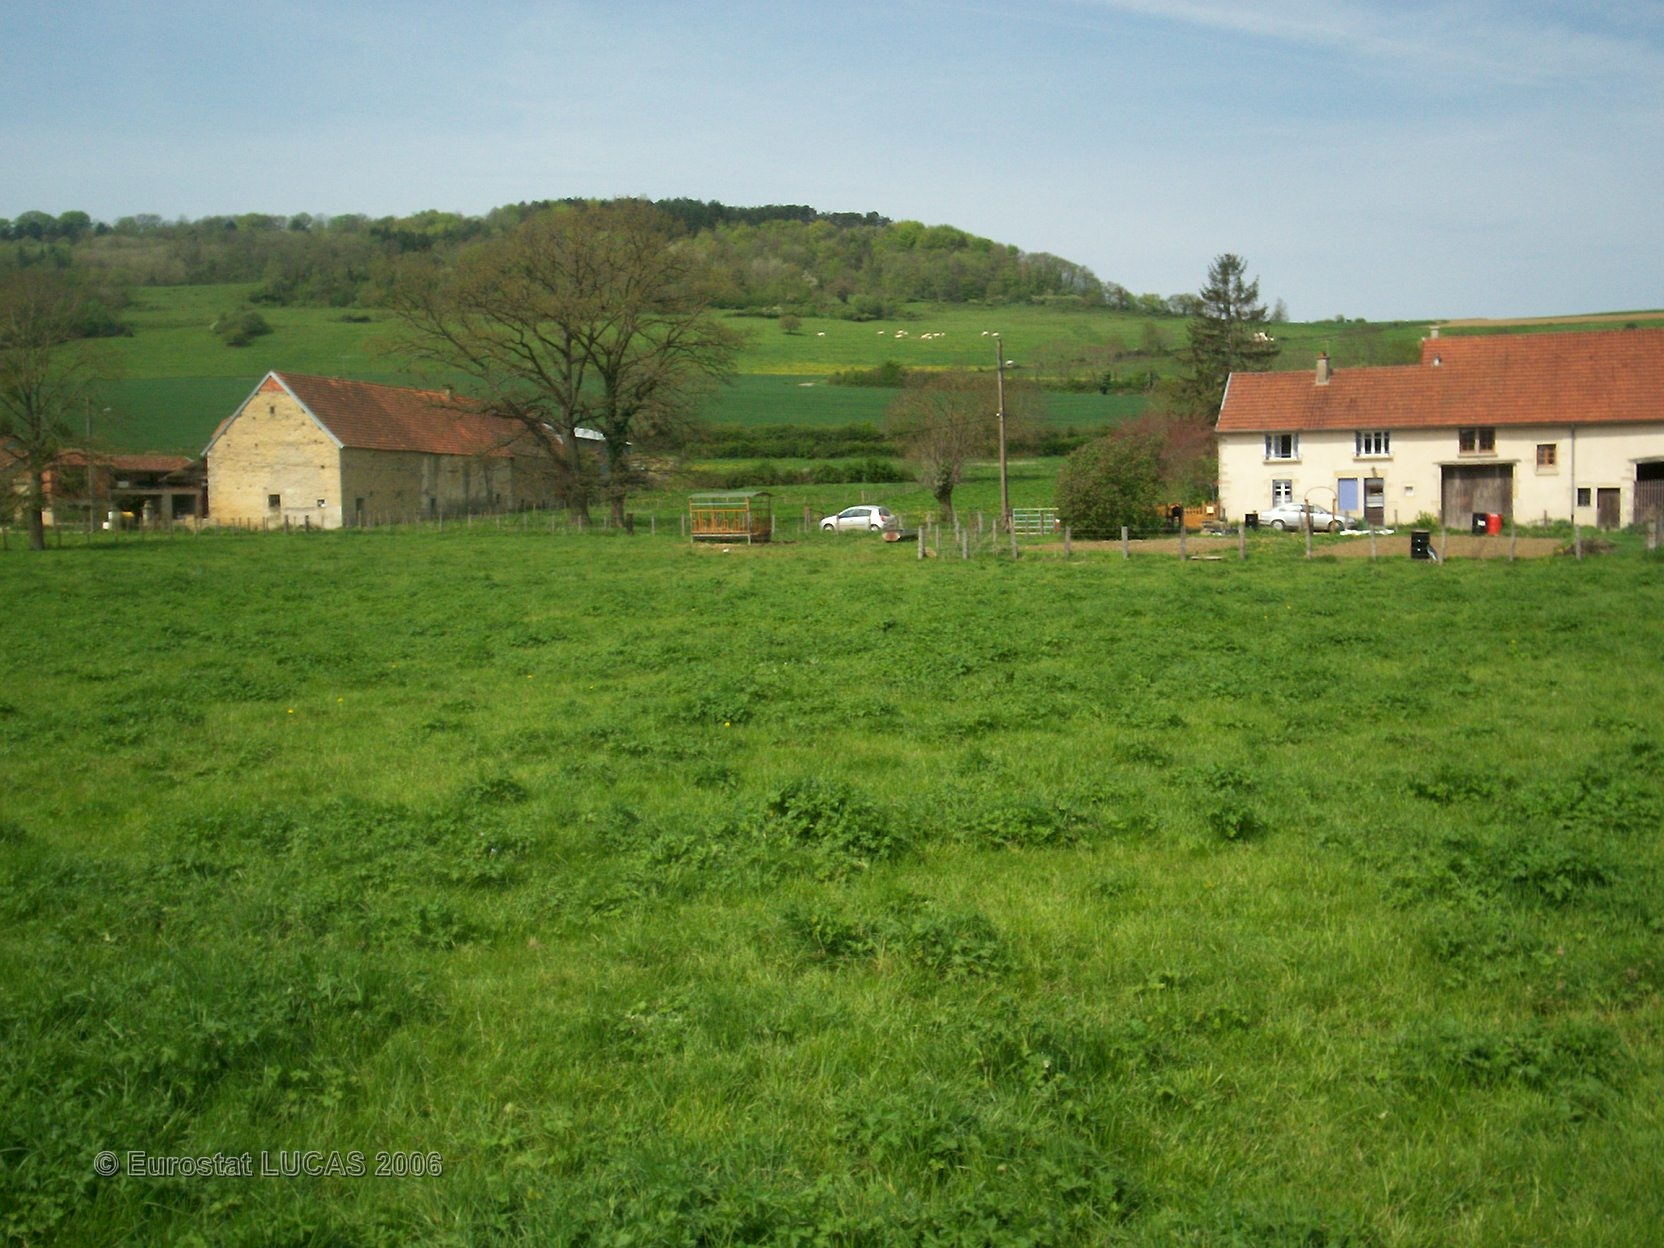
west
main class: Grassland
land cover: Grassland without tree/shrub cover
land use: Agriculture (excluding fallow land and kitchen gardens)
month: May
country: FR
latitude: 47.4420
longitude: 4.6023
